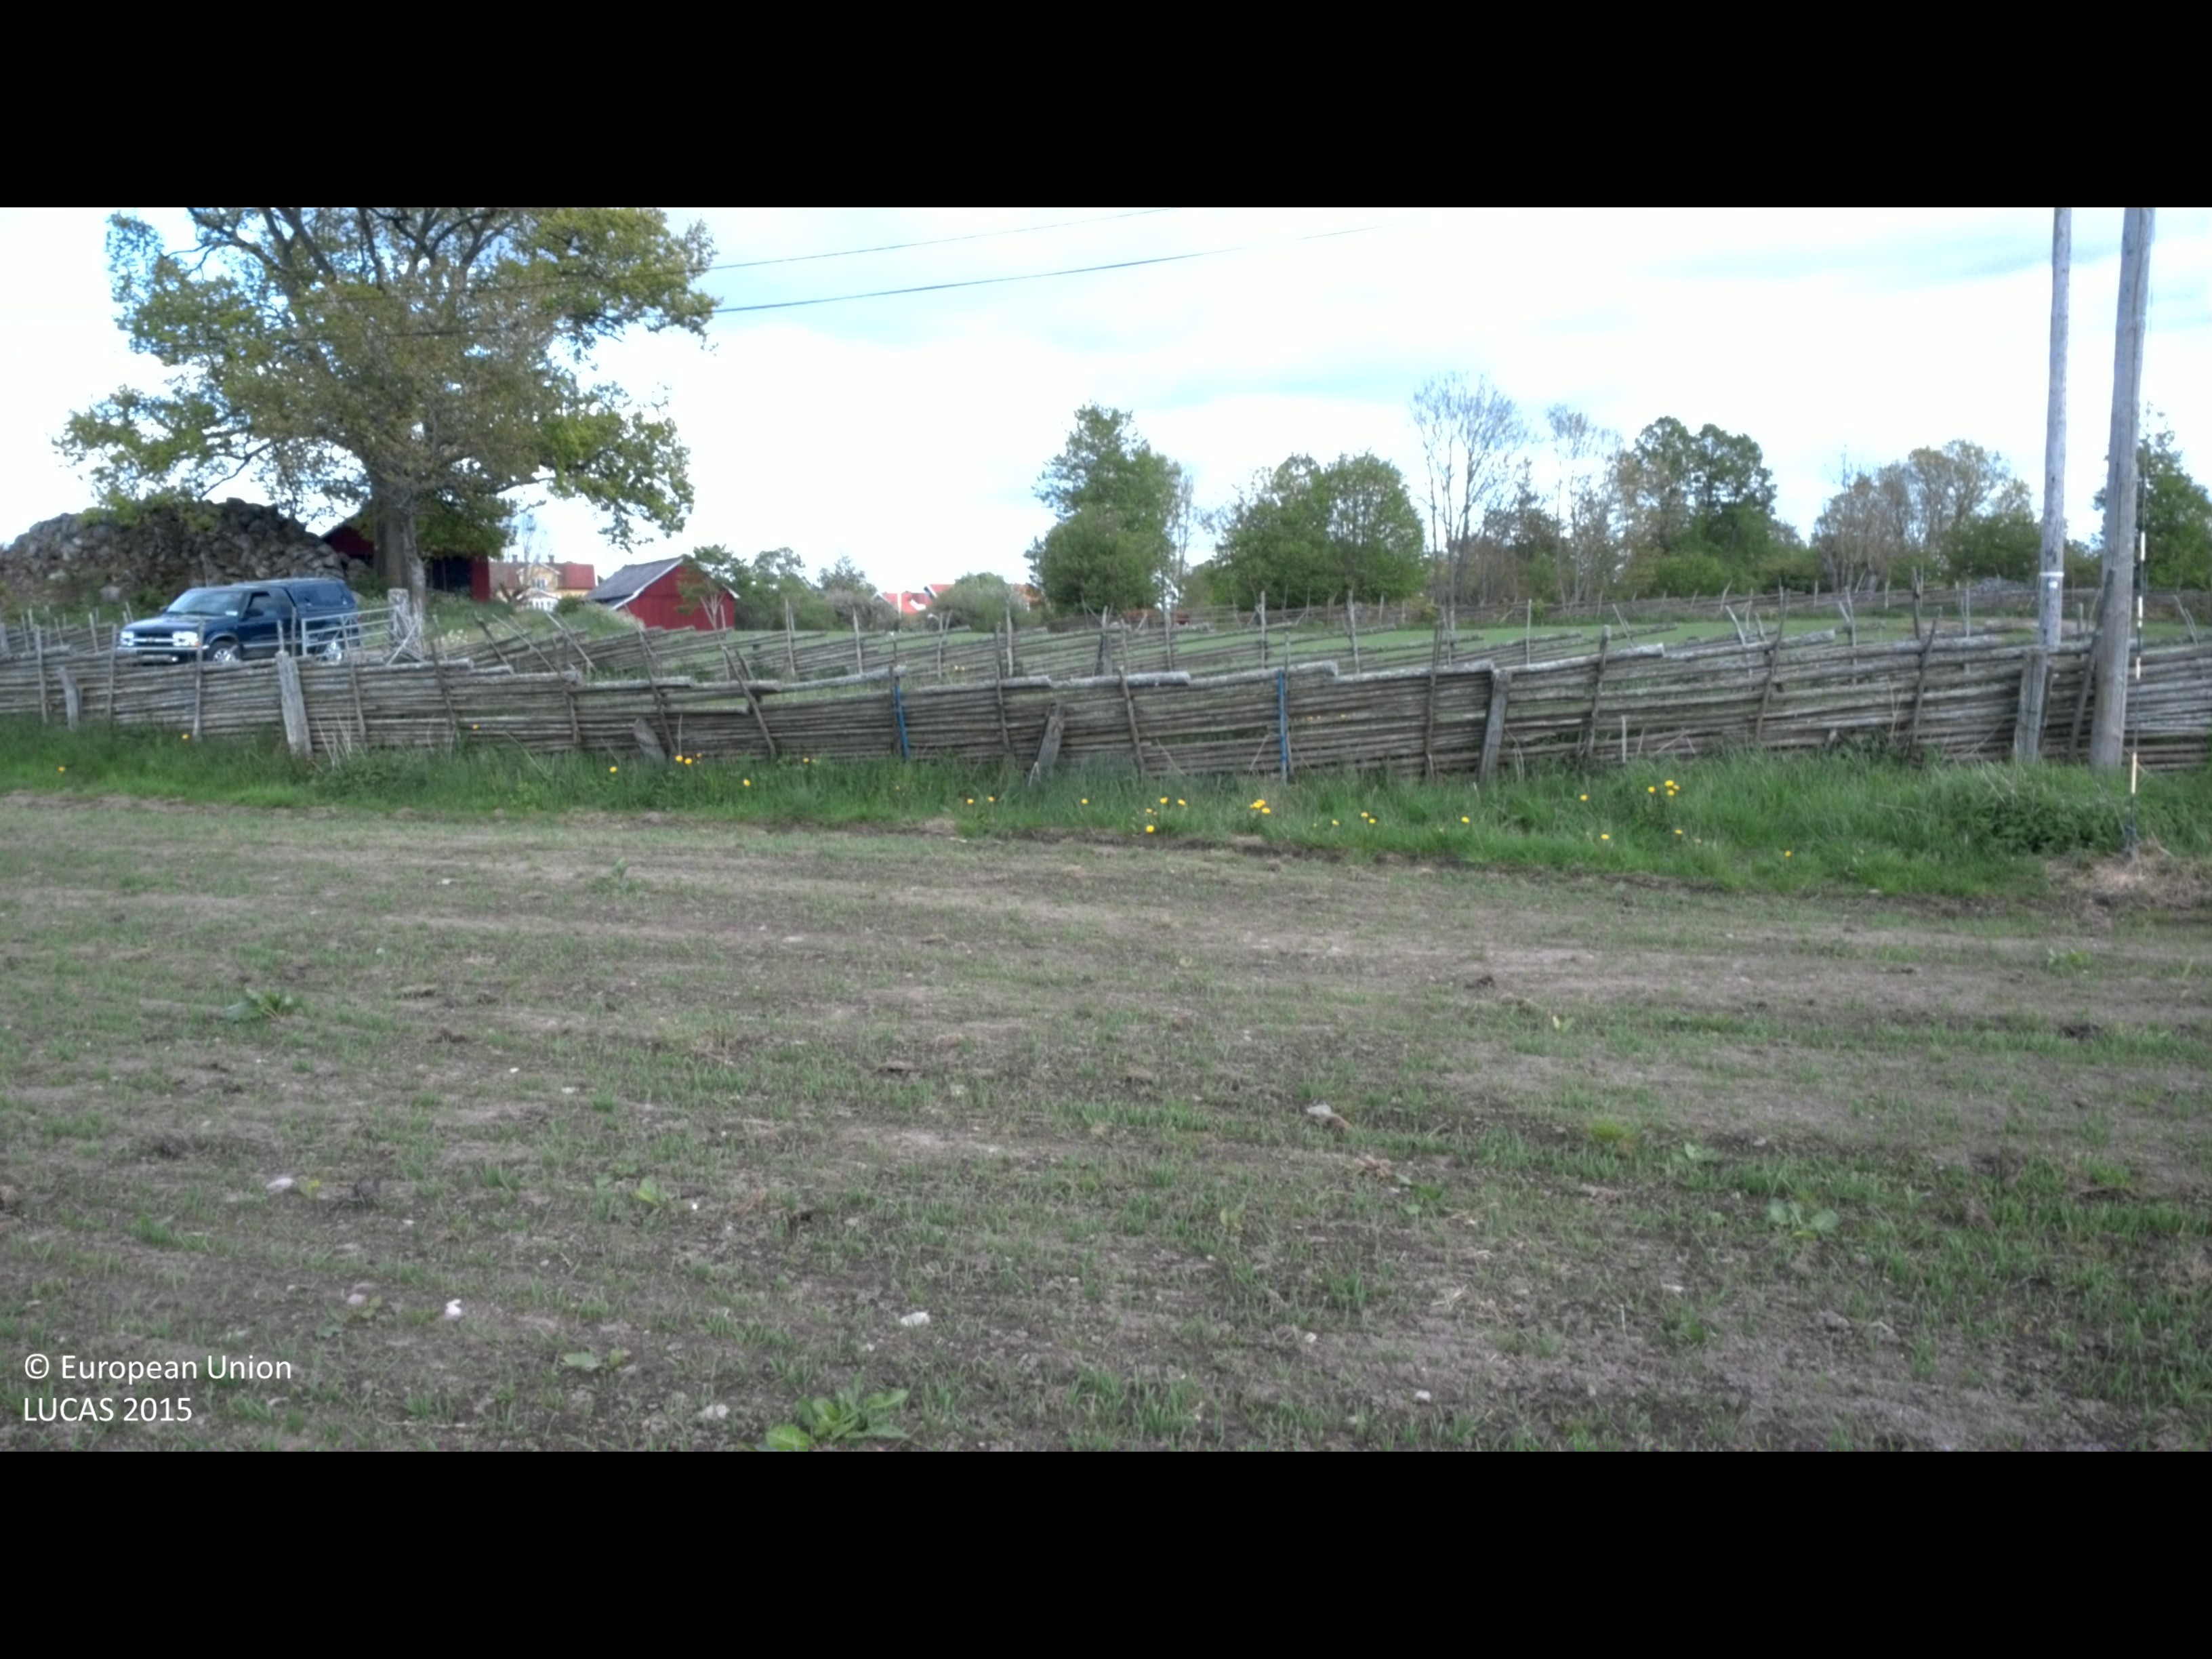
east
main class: Cropland
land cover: Temporary grasslands
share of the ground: < 10 %
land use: Agriculture (excluding fallow land and kitchen gardens)
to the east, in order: Temporary grasslands; Grass margins; Fences; Grass margins; Paved roads, cycling and walking lanes; Grass margins; Electric lines; Fences; Other leguminous and mixtures for fodder; Artificial constructions in urban areas
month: May
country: SE
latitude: 57.3385
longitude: 16.1624
